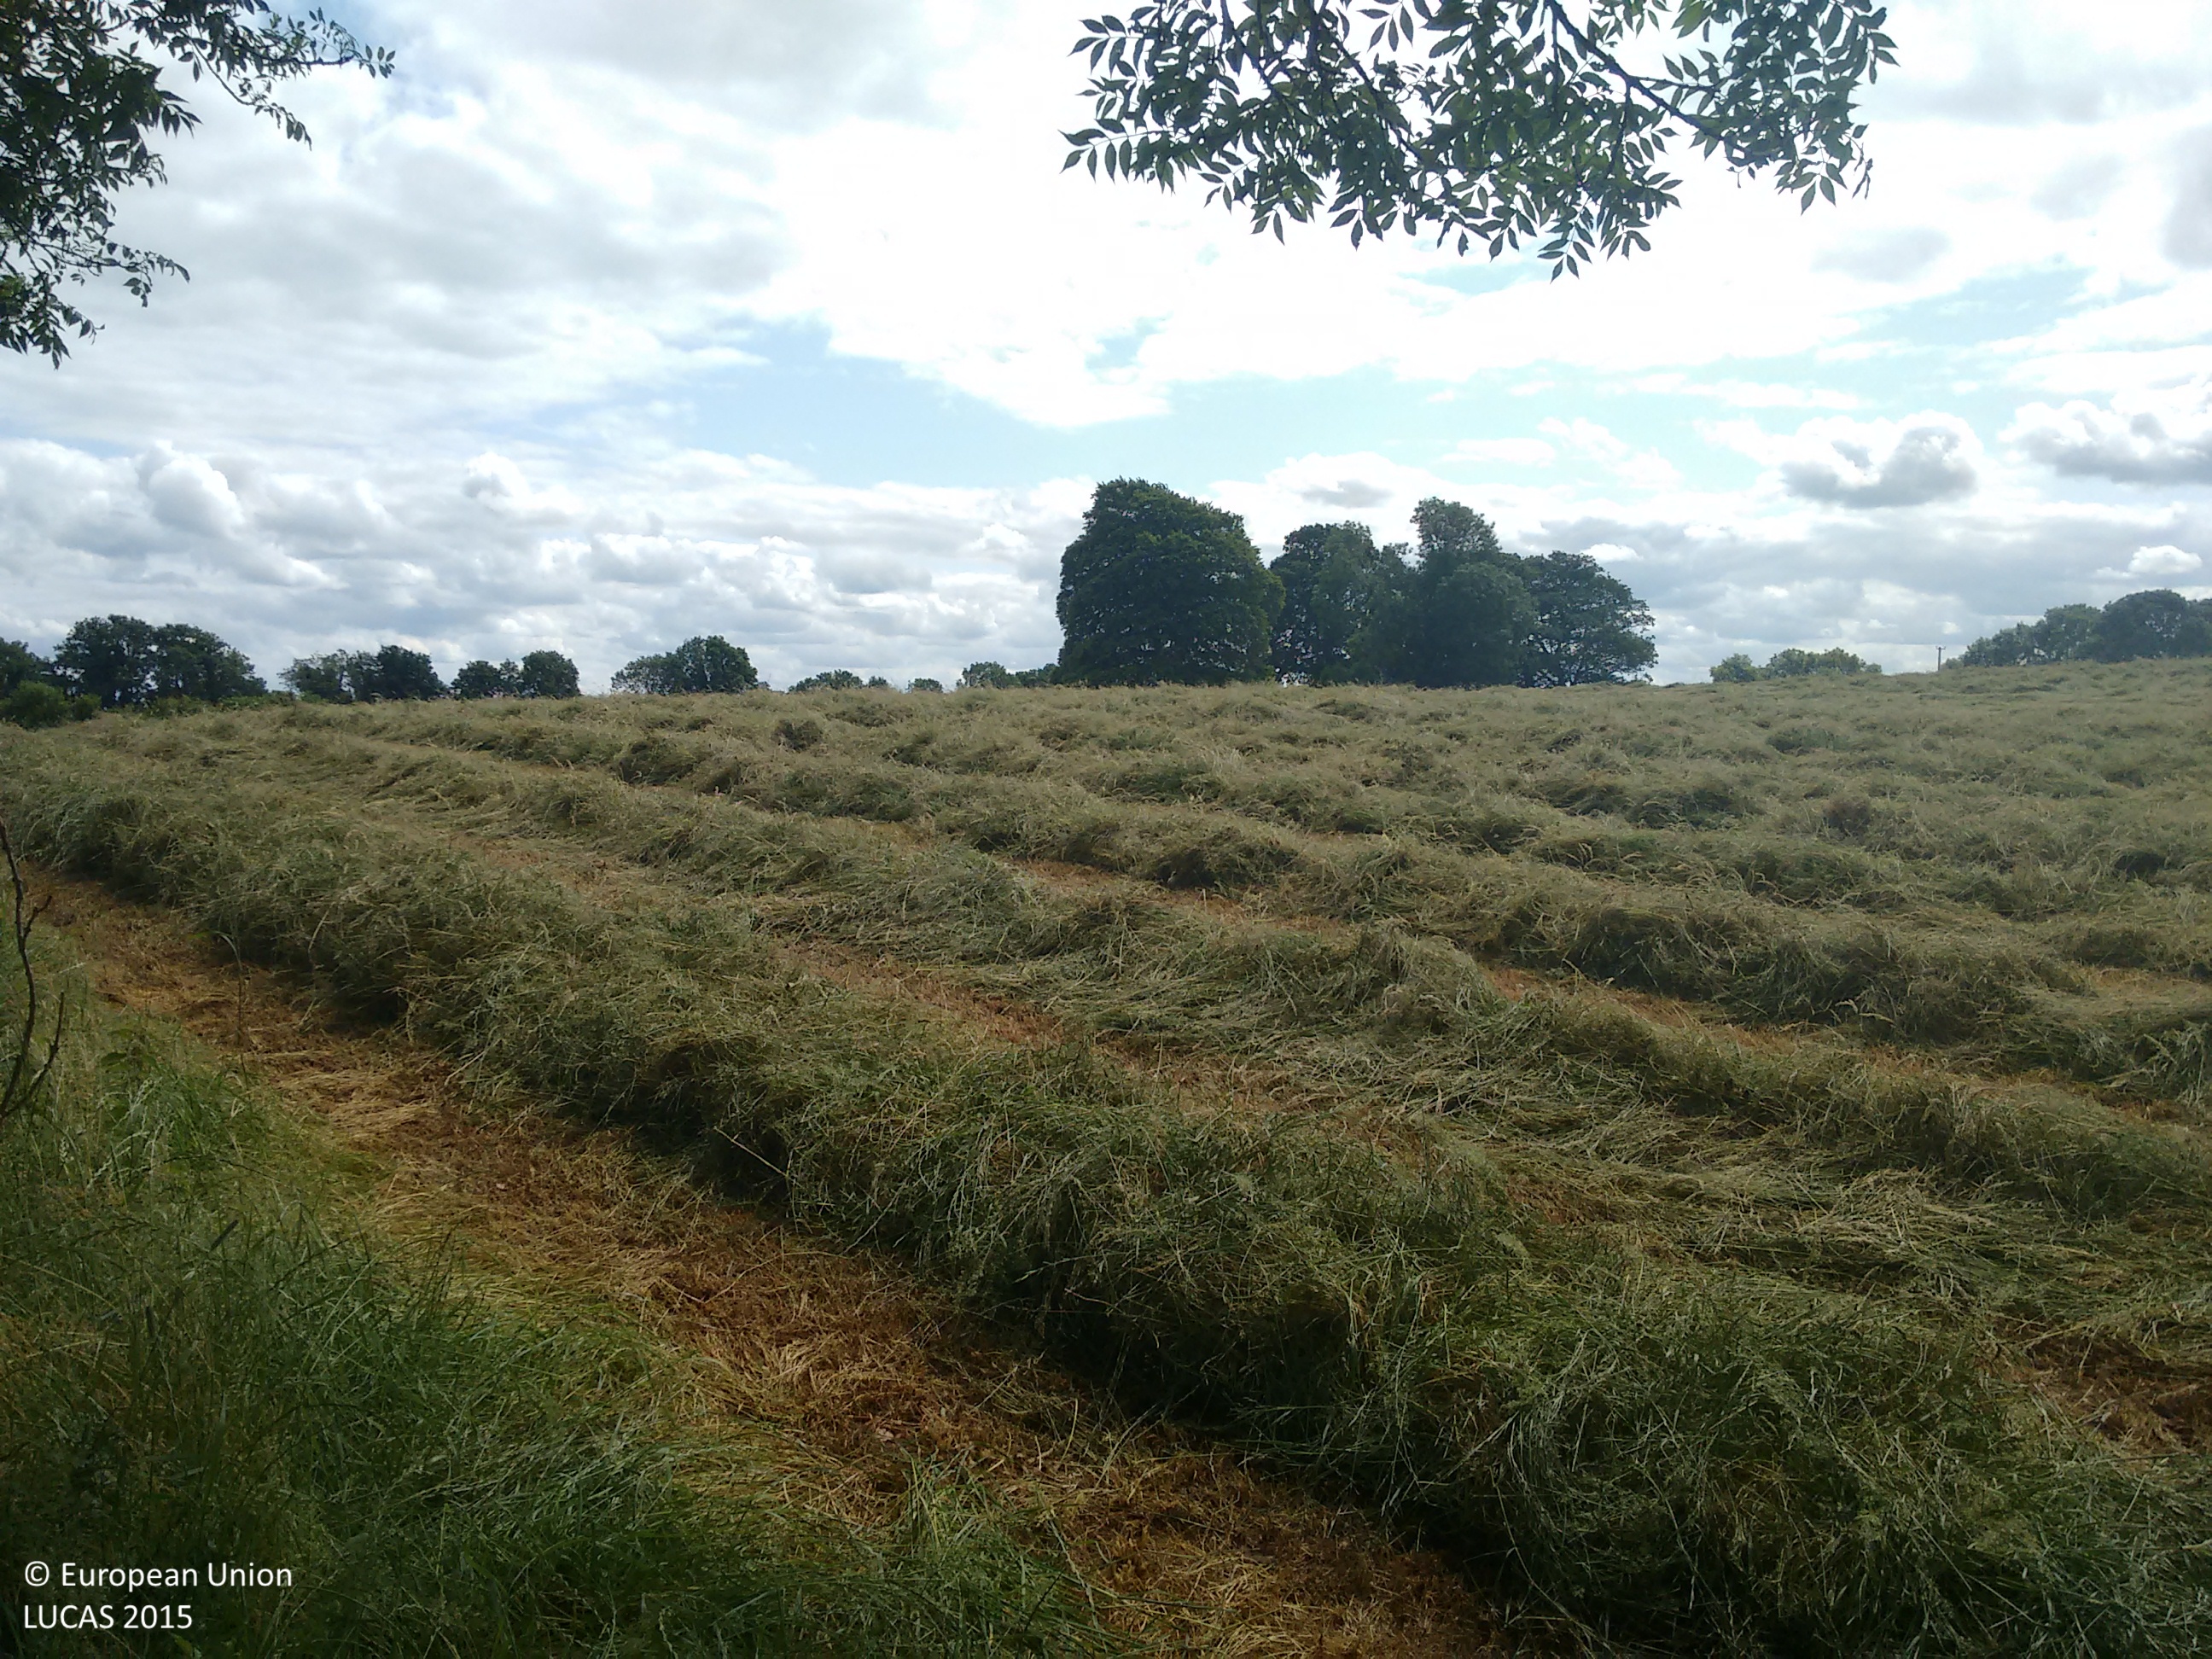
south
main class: Grassland
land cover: Grassland without tree/shrub cover
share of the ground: > 75 %
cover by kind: herbaceous plants 100 %
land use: Agriculture (excluding fallow land and kitchen gardens)
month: July
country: IE
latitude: 53.5458
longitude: -7.7794
